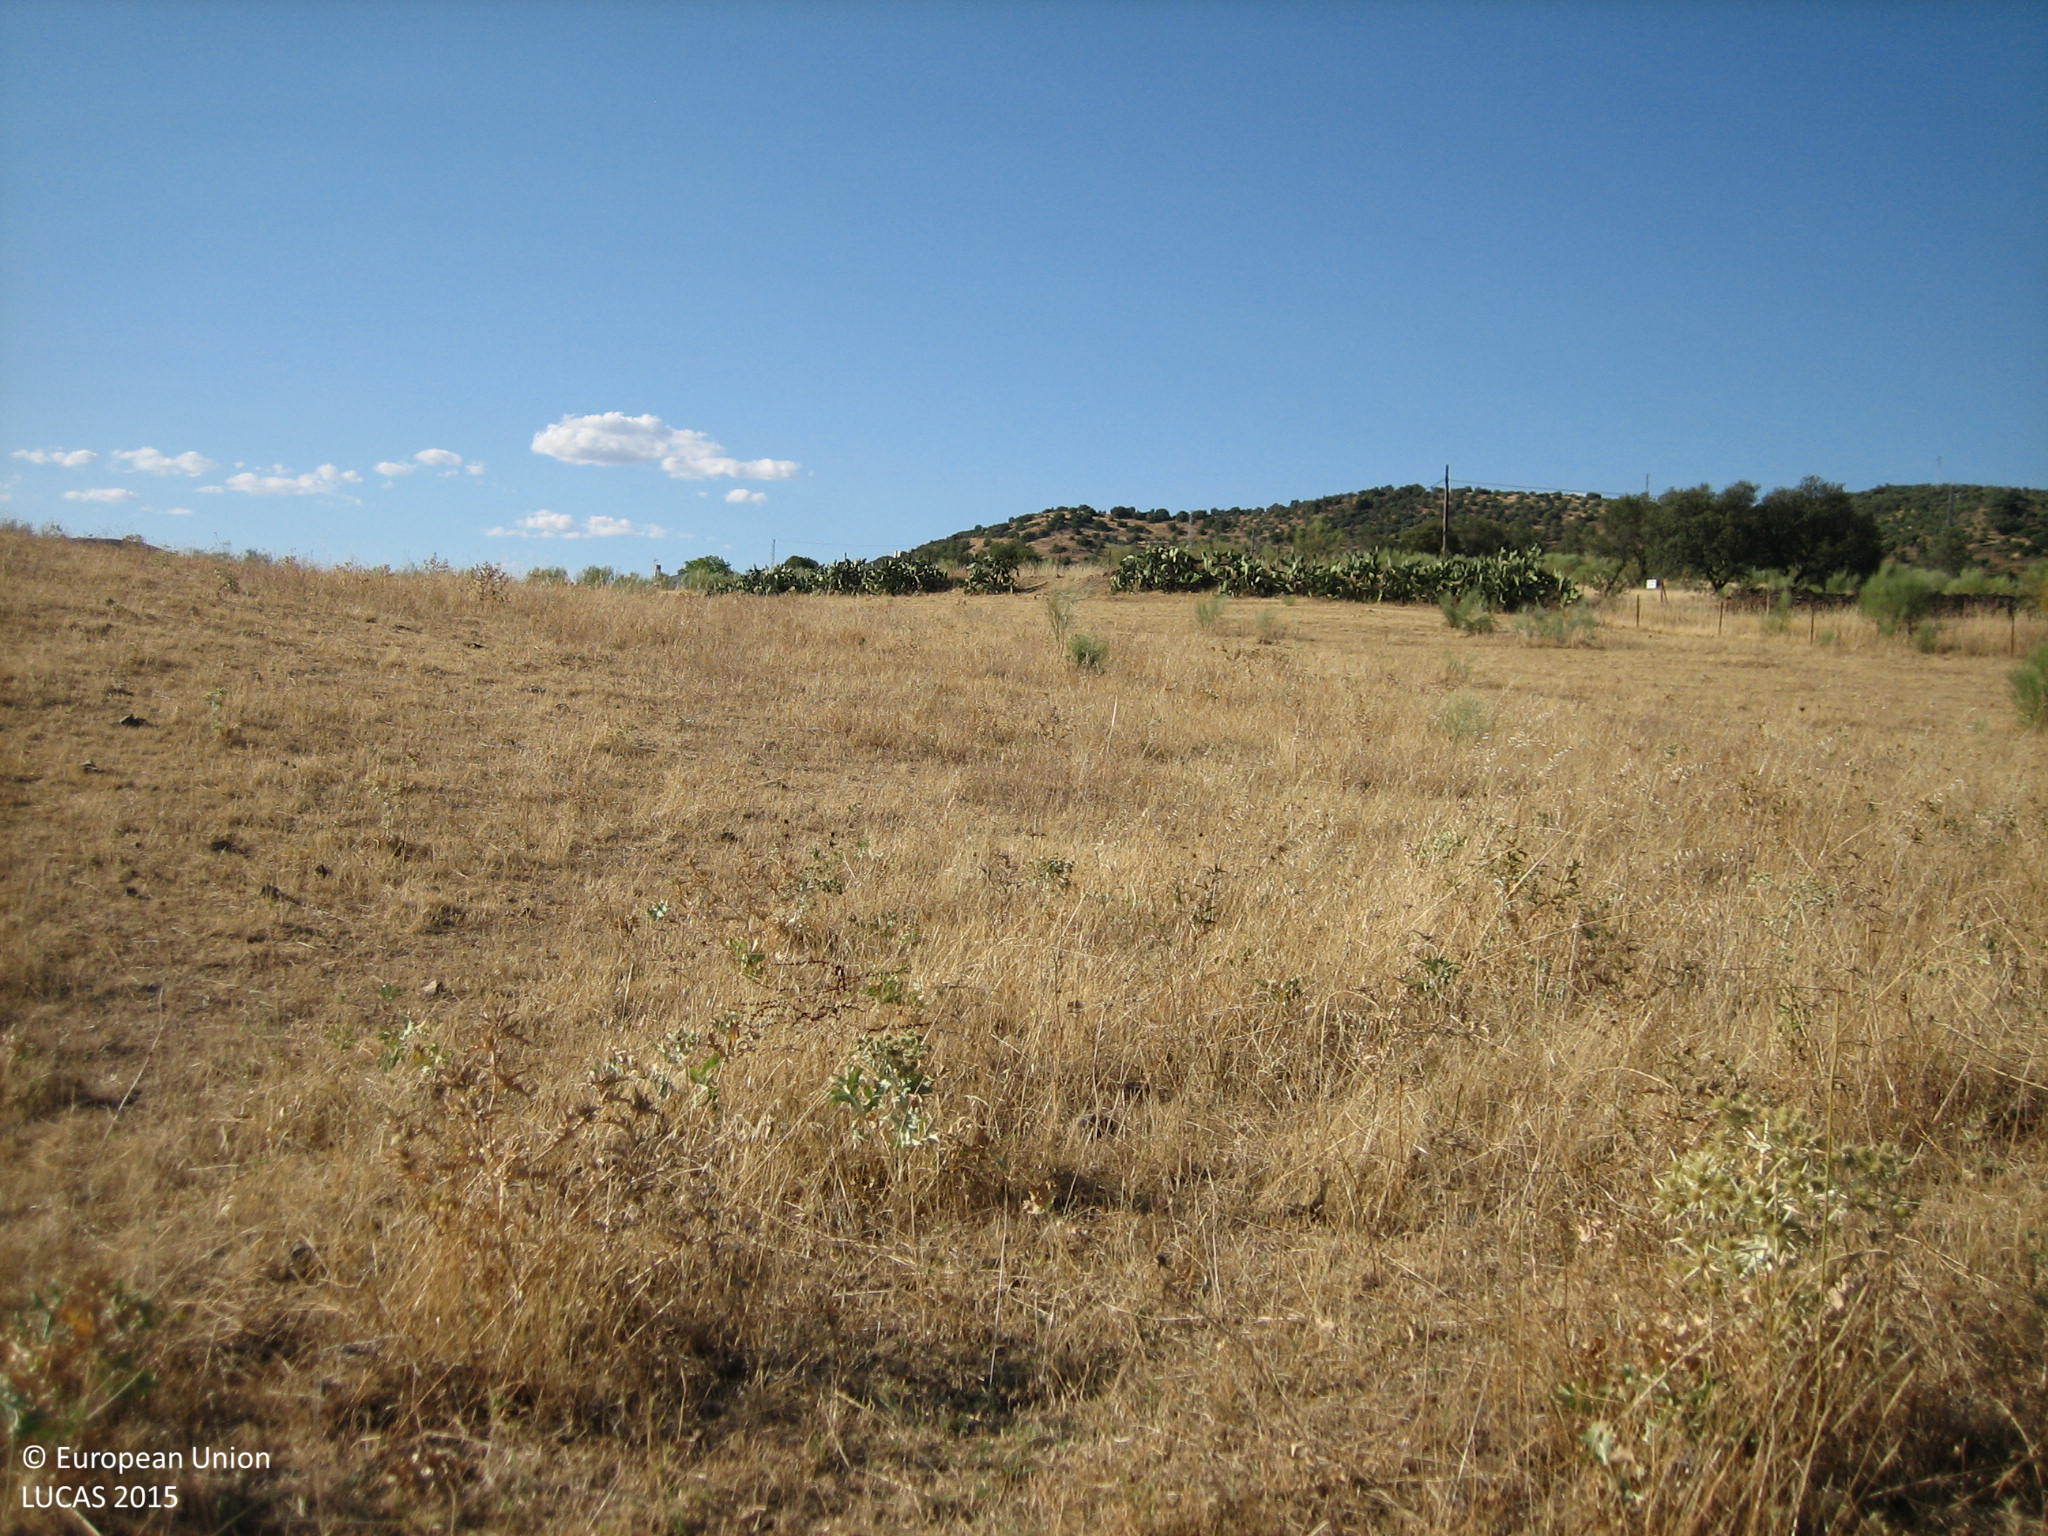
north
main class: Grassland
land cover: Grassland without tree/shrub cover
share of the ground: > 75 %
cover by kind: herbaceous plants 80 %, unconsolidated bare surface 20 %
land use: Agriculture (excluding fallow land and kitchen gardens)
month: July
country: ES
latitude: 38.0525
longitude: -6.0485
